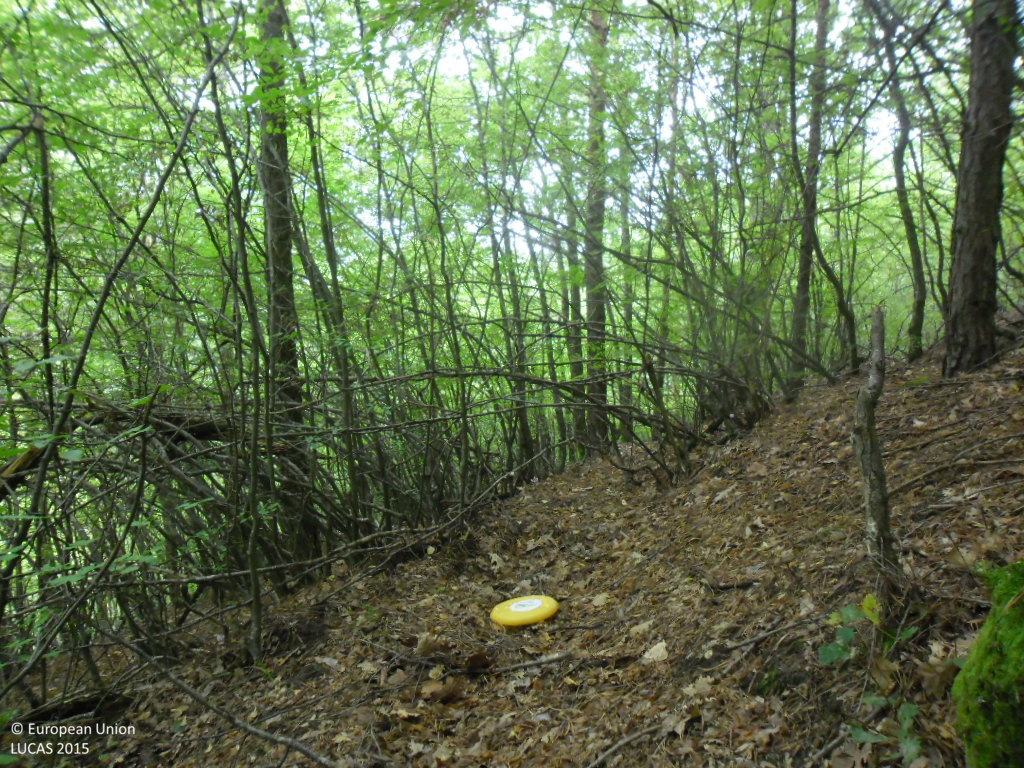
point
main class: Woodland
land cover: Pine dominated mixed woodland
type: hemiboreal forest and nemoral coniferous forest and mixed broadleaved-coniferous forest
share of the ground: > 75 %
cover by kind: coniferous forest trees 75 %, broadleaved forest trees 25 %
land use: Forestry
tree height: > 5 m
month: September
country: BG
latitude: 41.6147
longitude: 23.1129
